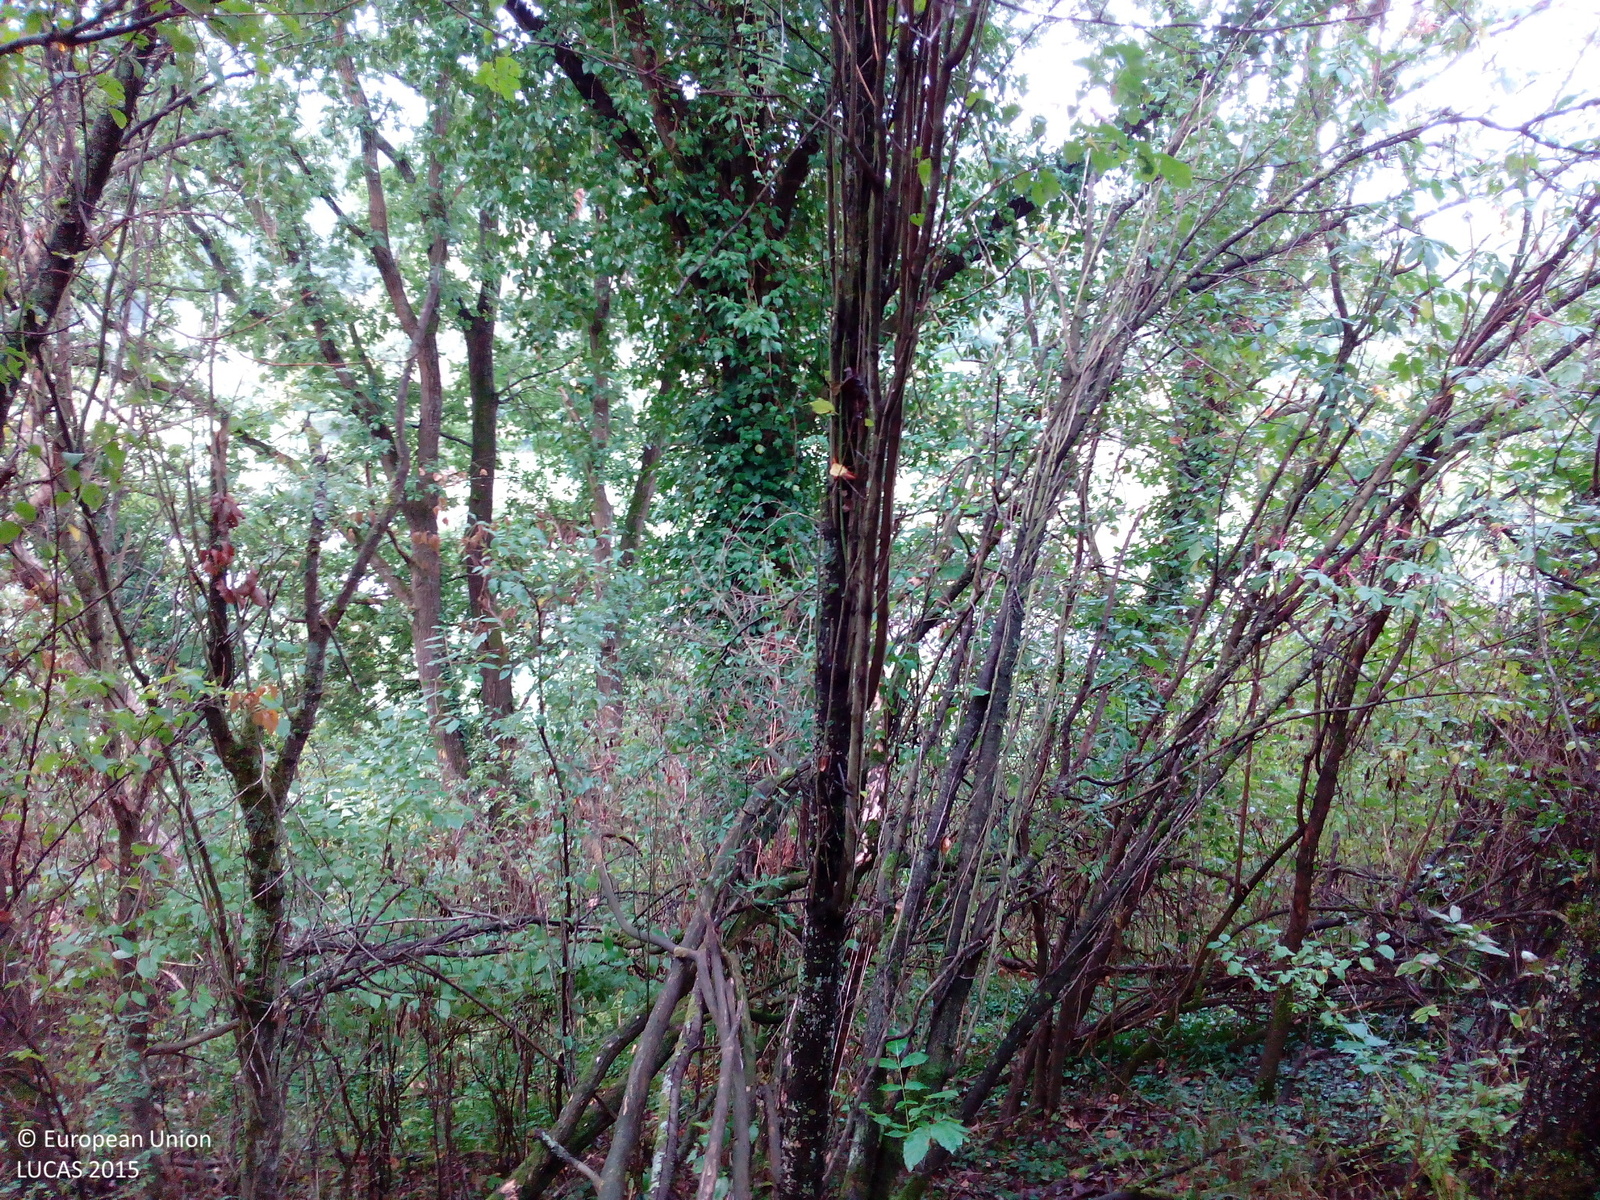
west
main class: Woodland
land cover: Broadleaved woodland
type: mesophytic deciduous forest
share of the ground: > 75 %
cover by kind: broadleaved forest trees 75 %, shrubs 20 %, herbaceous plants 5 %
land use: Semi-natural and natural areas not in use
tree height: < 5 m
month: September
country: DE
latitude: 49.7690
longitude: 9.4032
